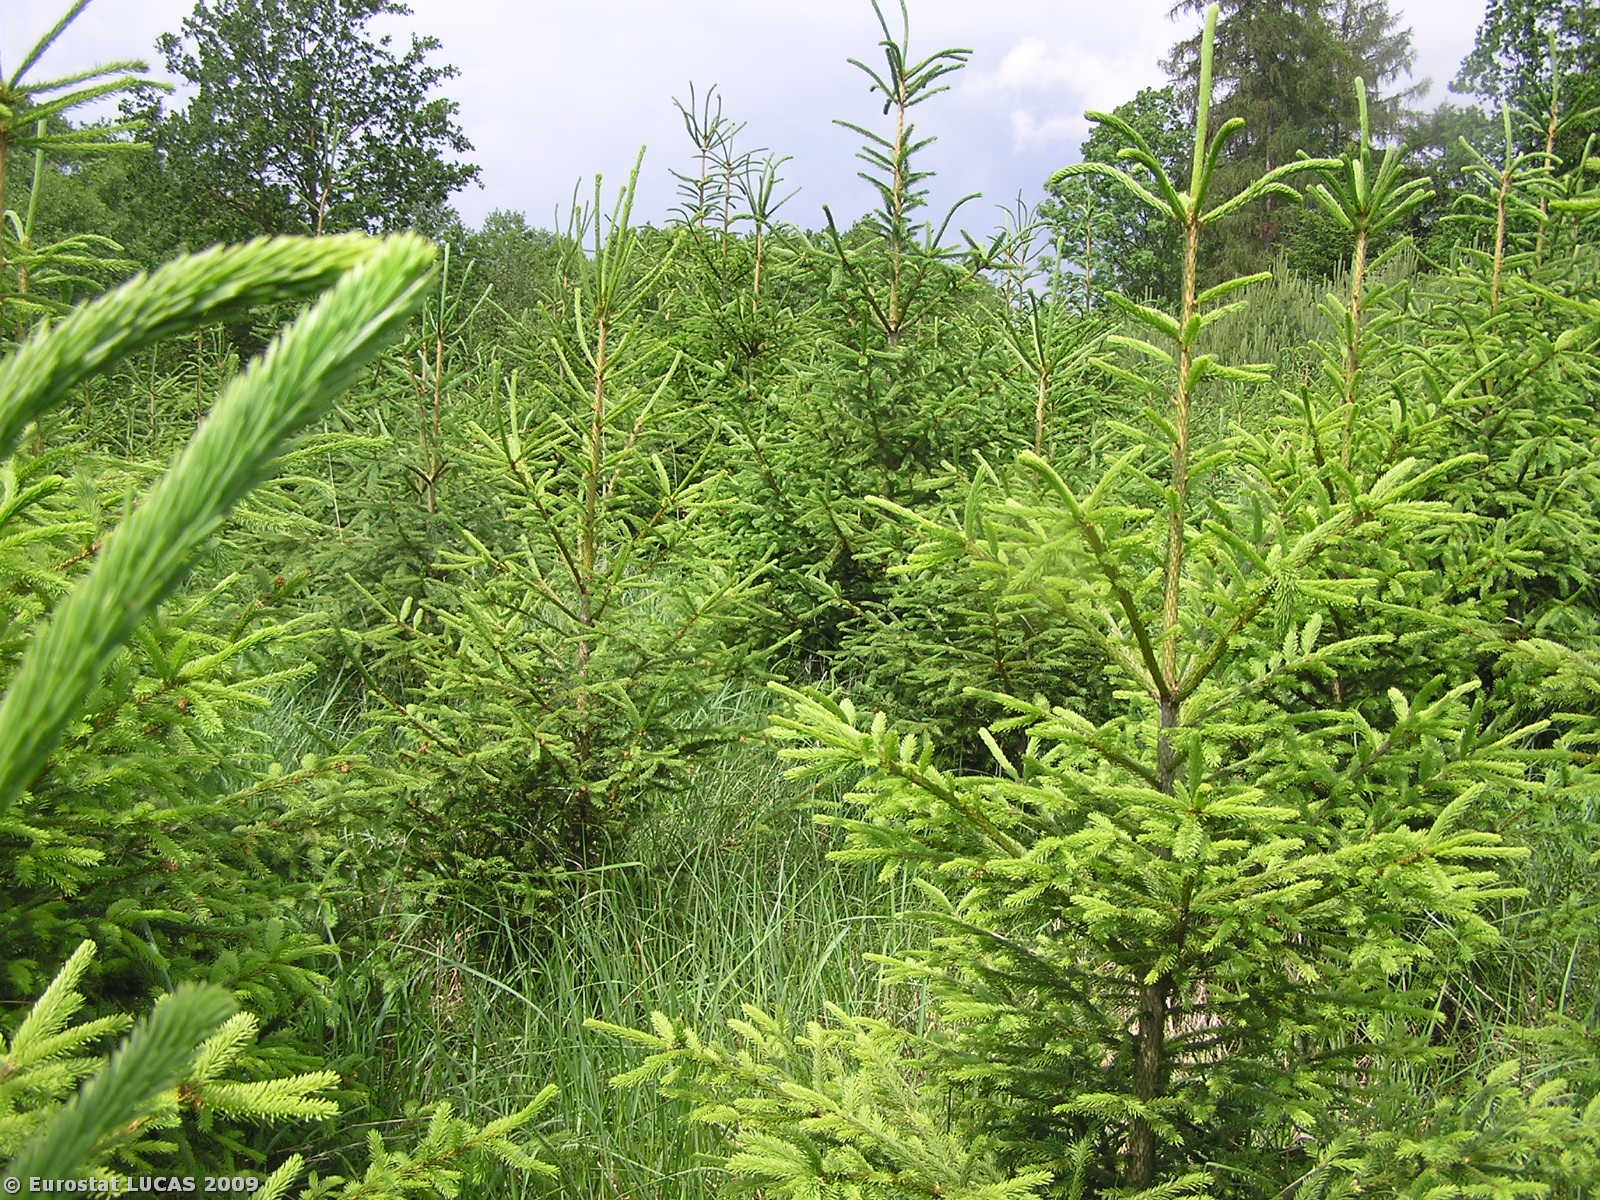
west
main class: Woodland
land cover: Coniferous woodland
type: hemiboreal forest and nemoral coniferous forest and mixed broadleaved-coniferous forest
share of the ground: > 75 %
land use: Forestry
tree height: > 5 m
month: June
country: CZ
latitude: 49.6421
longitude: 15.0018
